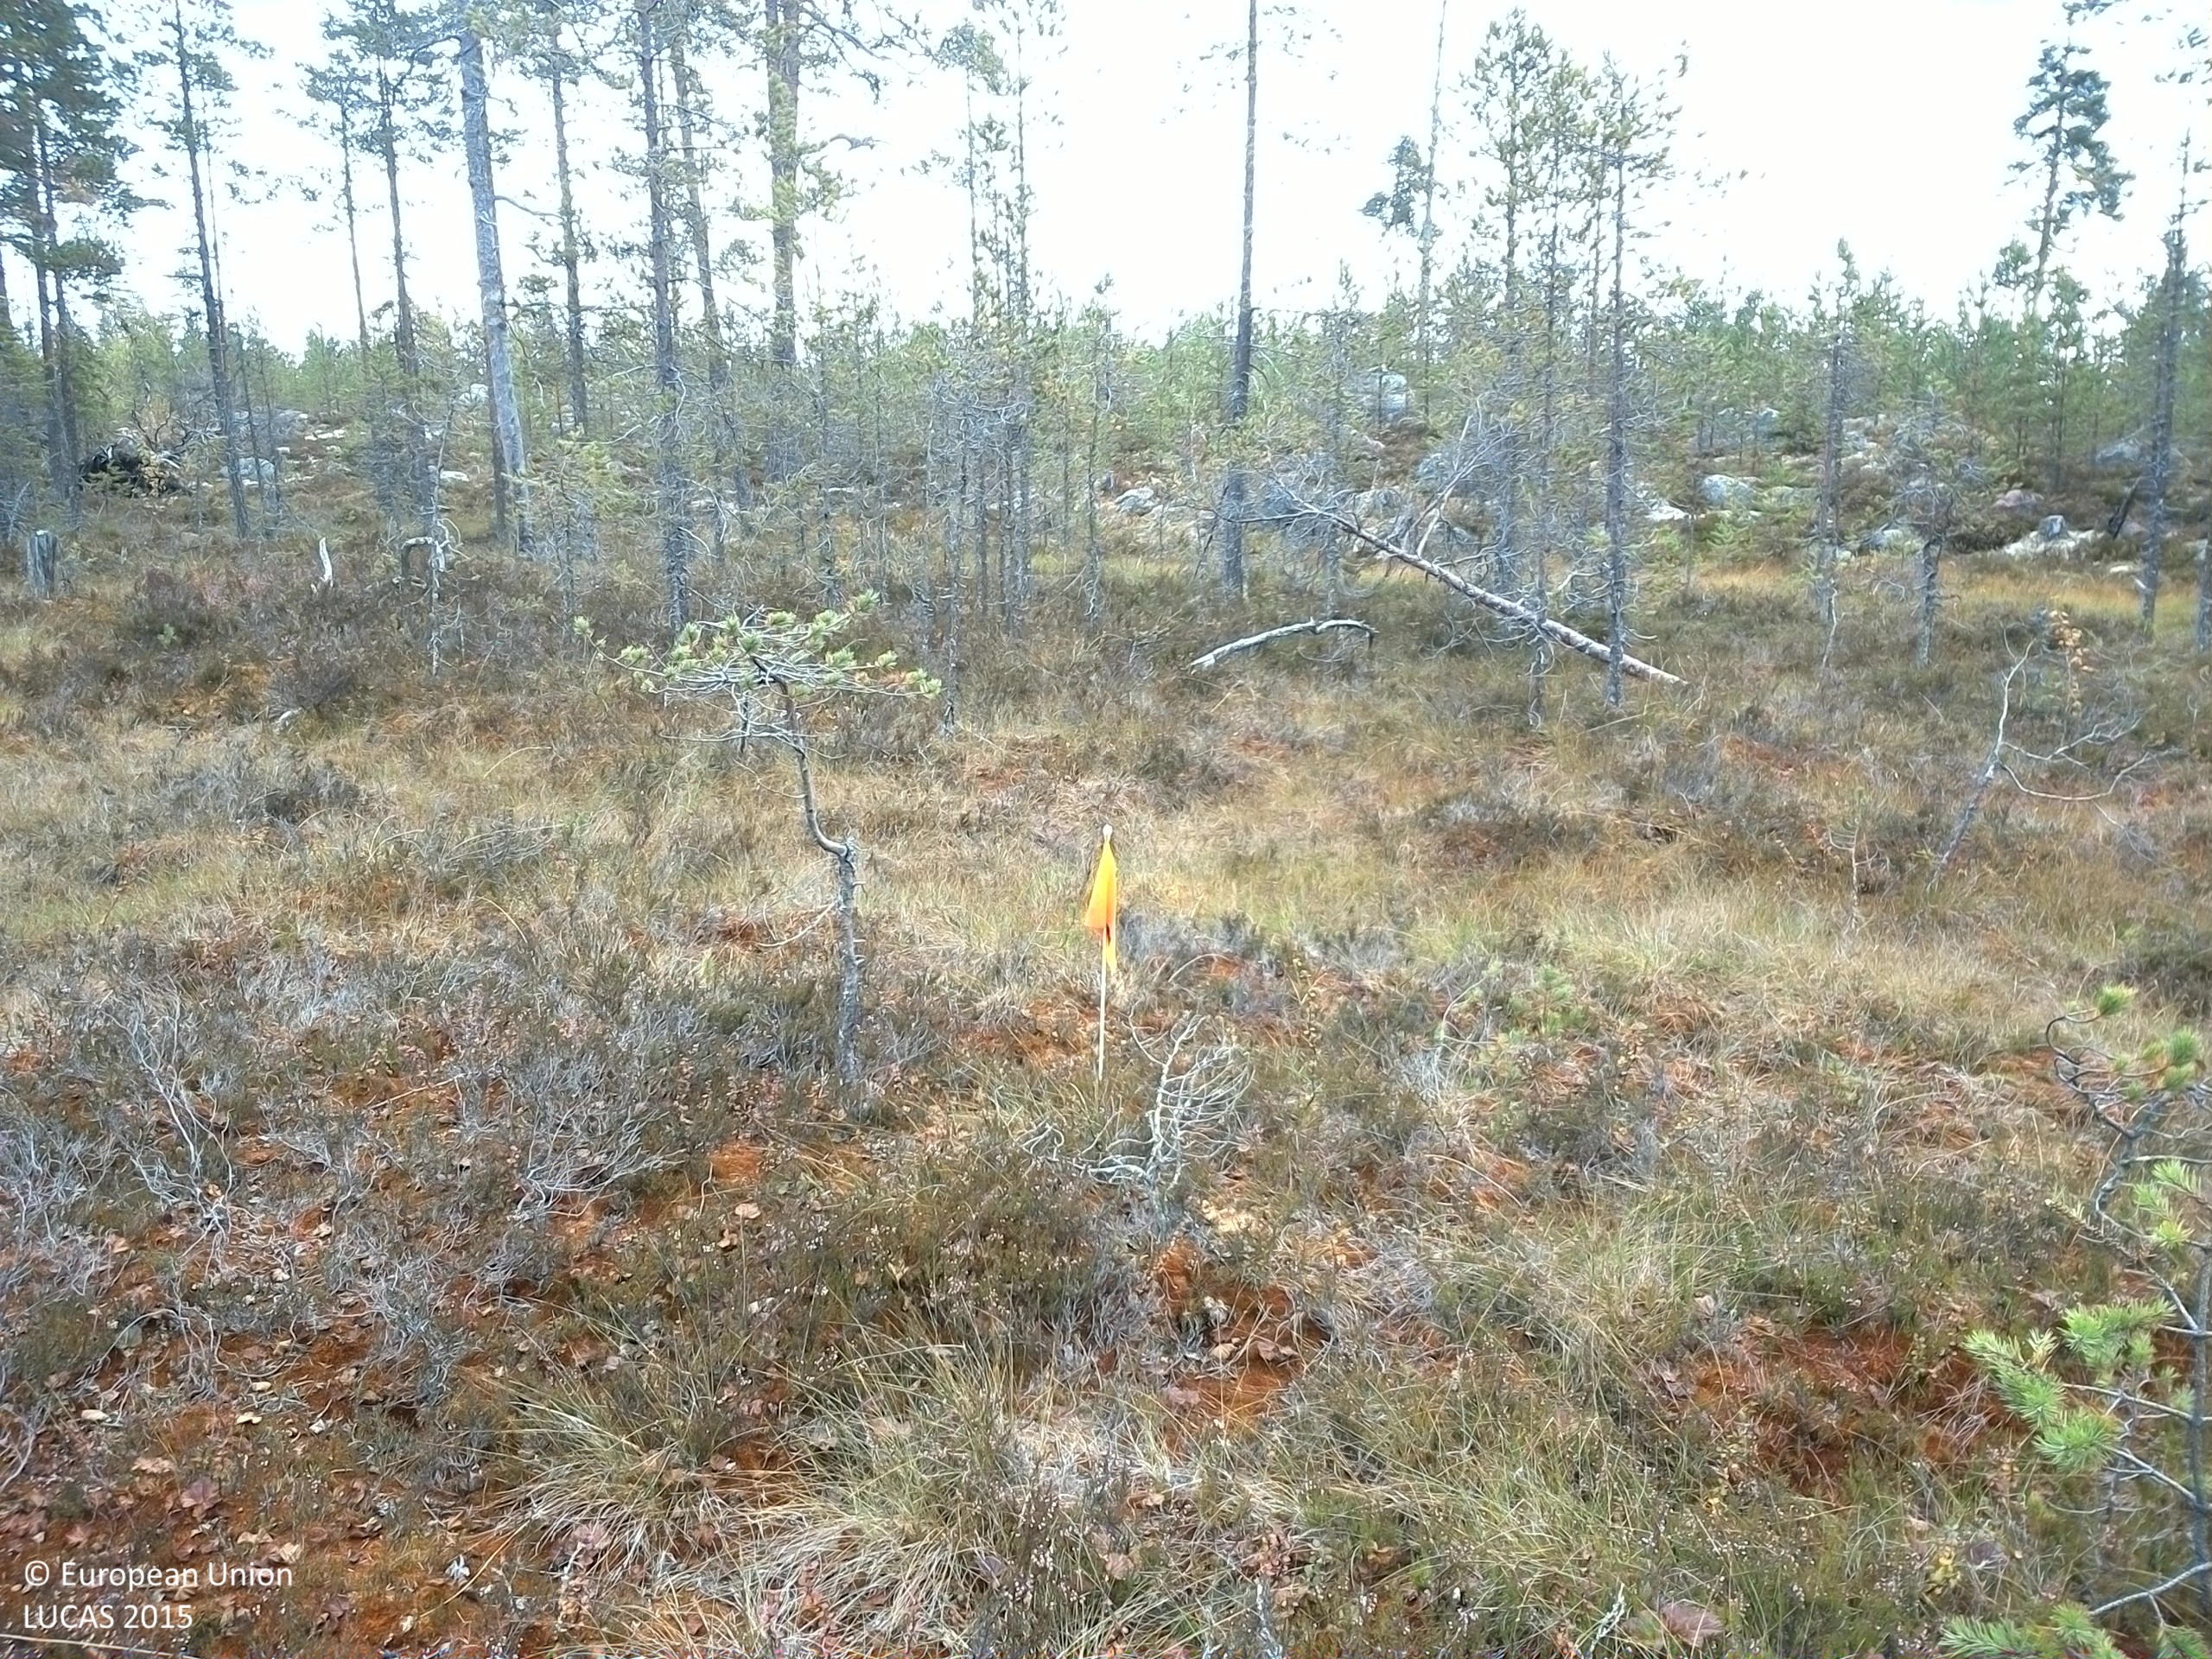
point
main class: Woodland
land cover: Pine dominated coniferous woodland
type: mire and swamp forests
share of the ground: 10 - 25 %
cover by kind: shrubs 40 %, lichens and mosses 40 %, coniferous forest trees 20 %
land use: Semi-natural and natural areas not in use
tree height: < 5 m
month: September
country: SE
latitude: 61.5344
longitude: 15.0434
